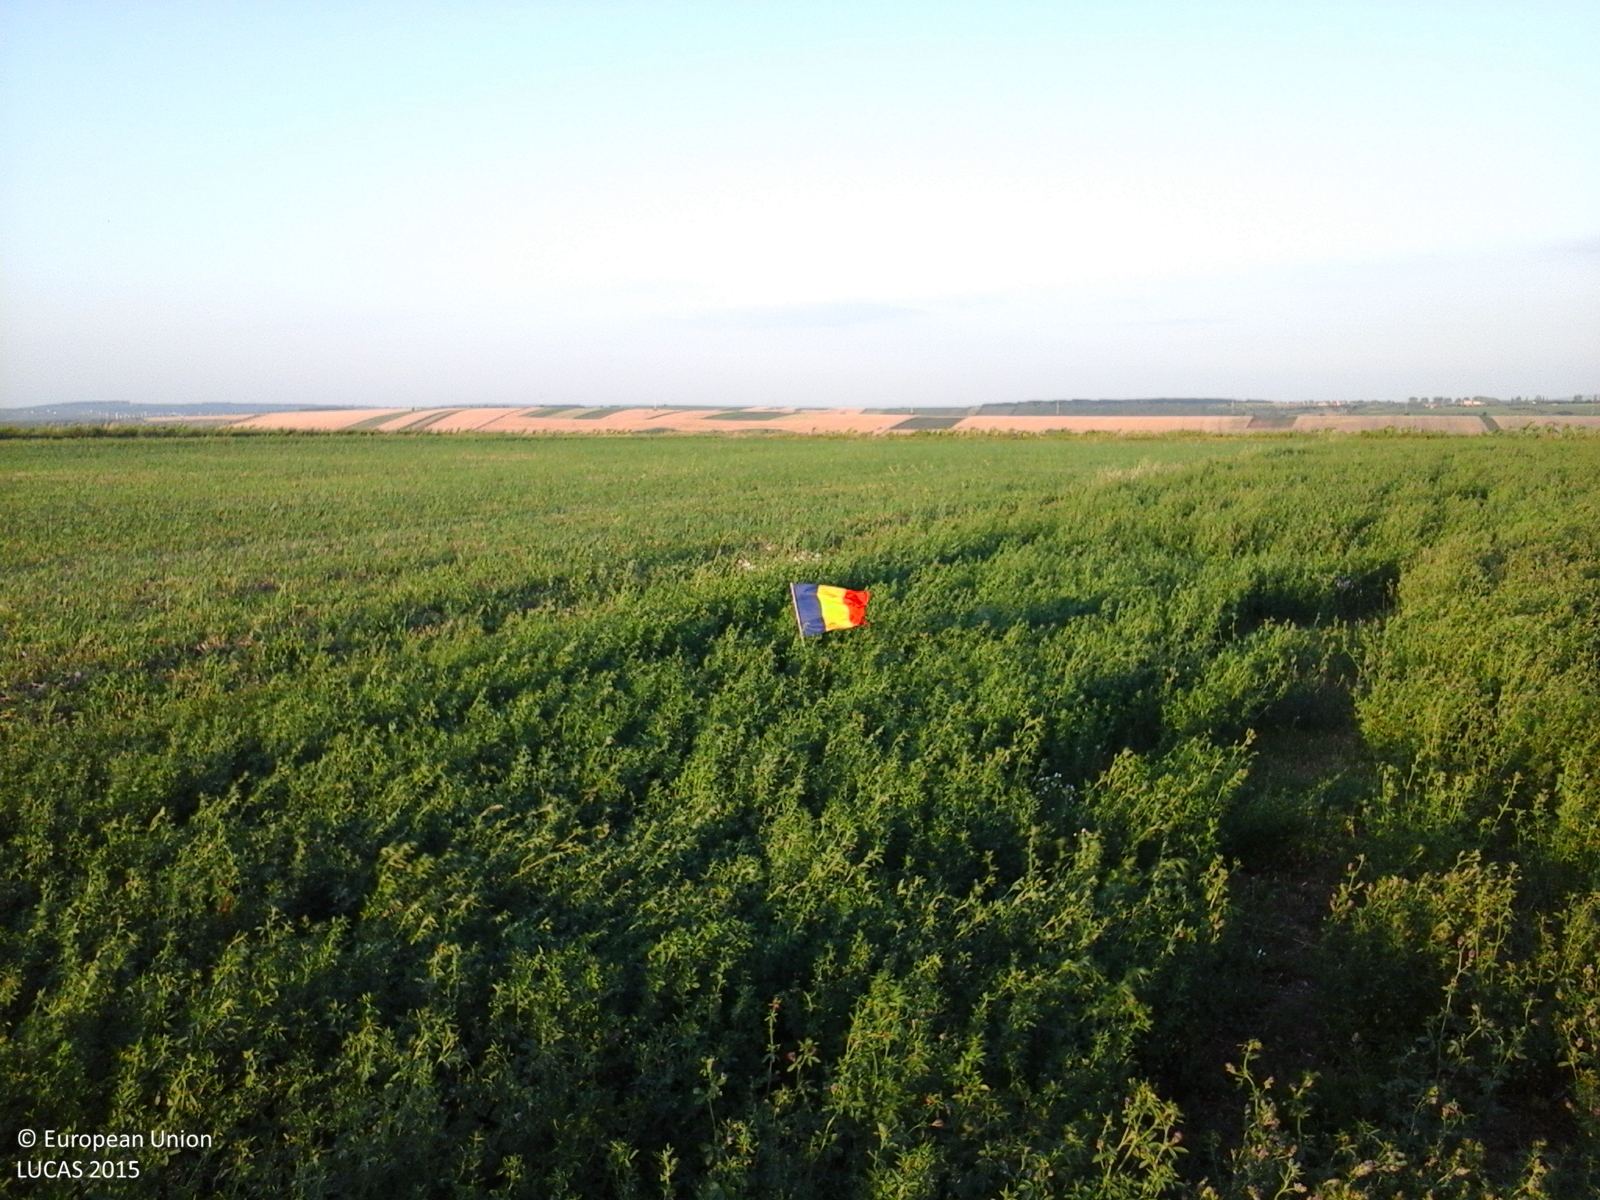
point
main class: Cropland
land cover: Lucerne
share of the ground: > 75 %
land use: Agriculture (excluding fallow land and kitchen gardens)
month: June
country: RO
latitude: 47.1343
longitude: 27.4241
